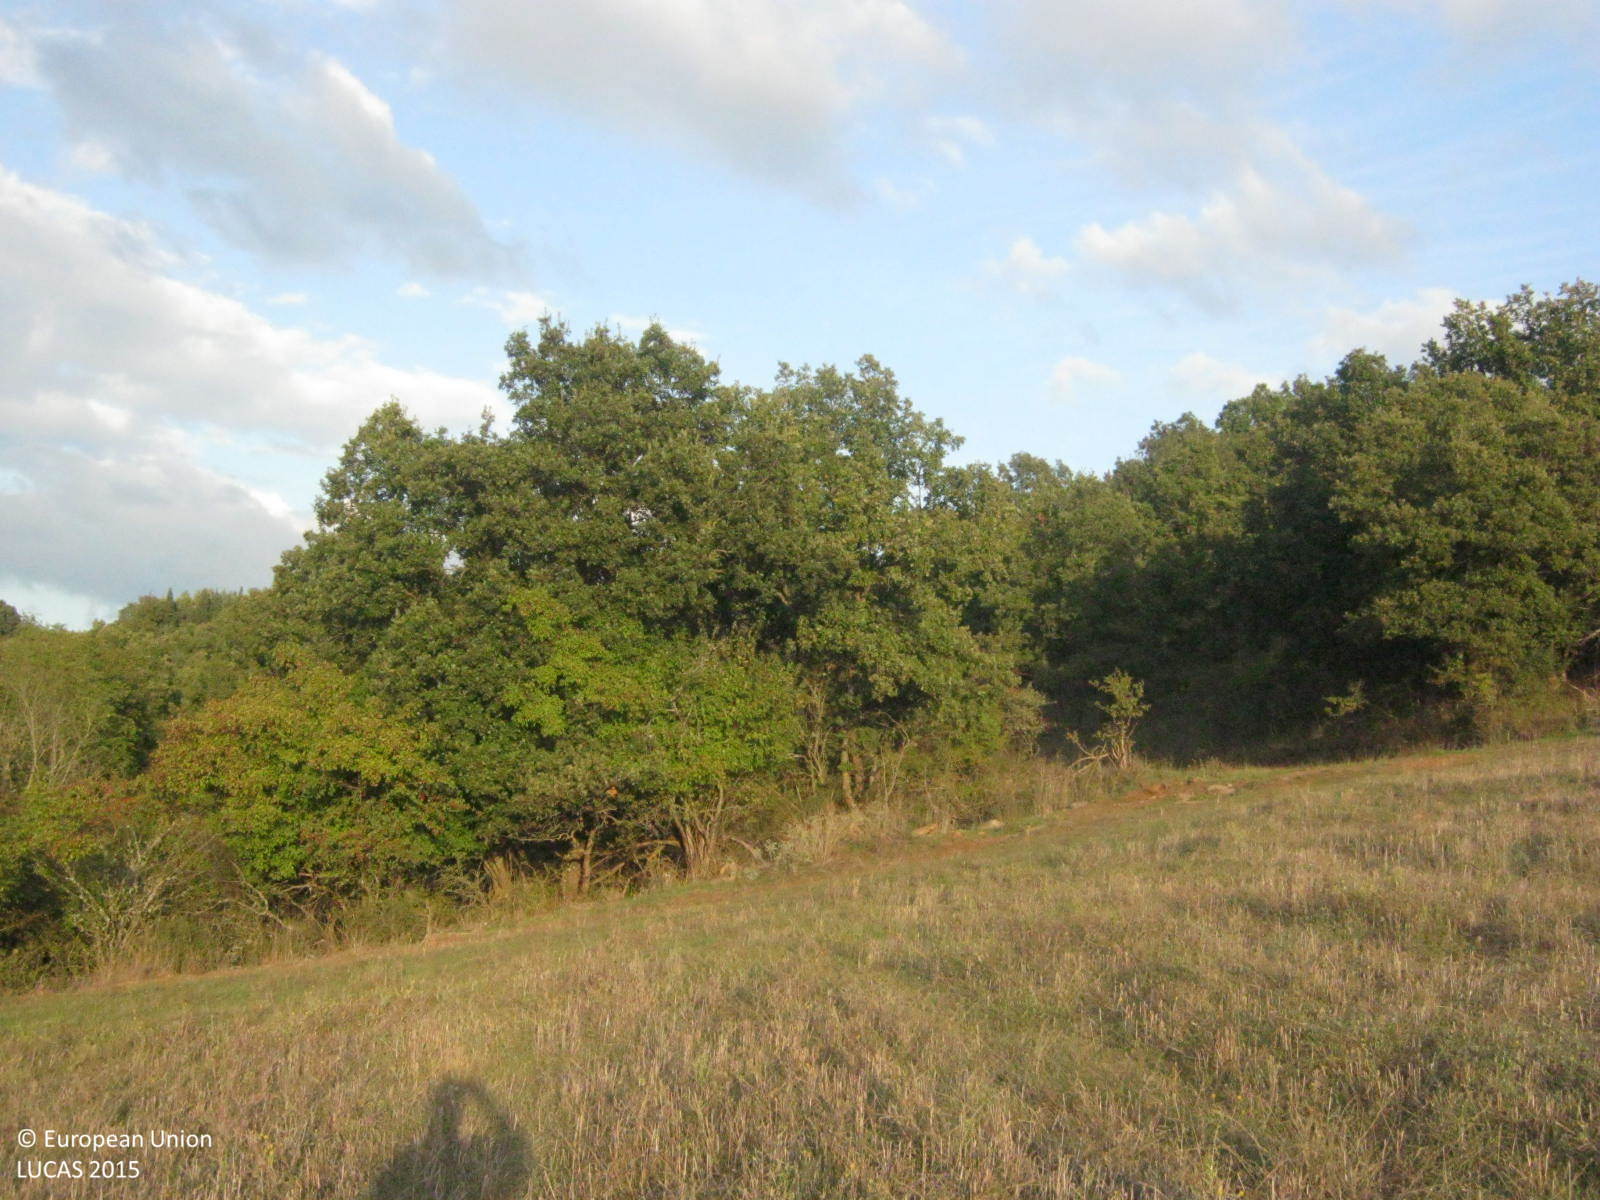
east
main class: Cropland
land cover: Common wheat
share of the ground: > 75 %
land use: Agriculture (excluding fallow land and kitchen gardens)
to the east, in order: Common wheat; Broadleaved woodland; Shrubland with sparse tree cover; Broadleaved woodland
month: September
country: GR
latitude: 41.0458
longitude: 22.9917
